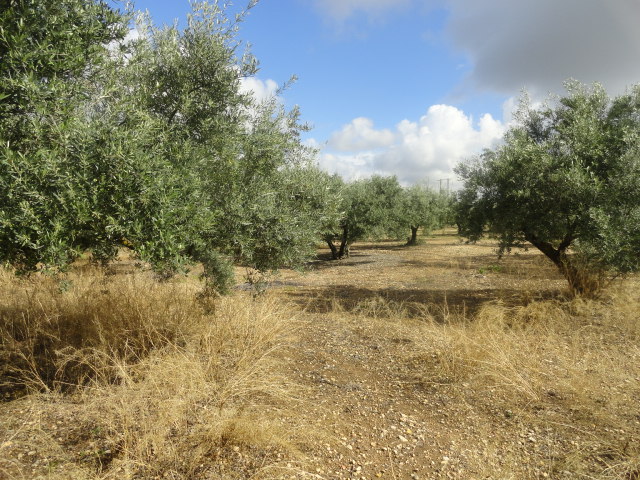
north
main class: Cropland
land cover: Olive groves
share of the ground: 50 - 75 %
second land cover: Spontaneously vegetated surfaces
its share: 10 - 25 %
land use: Agriculture (excluding fallow land and kitchen gardens)
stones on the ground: > 50 %
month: April
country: ES
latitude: 37.6093
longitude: -4.5865
